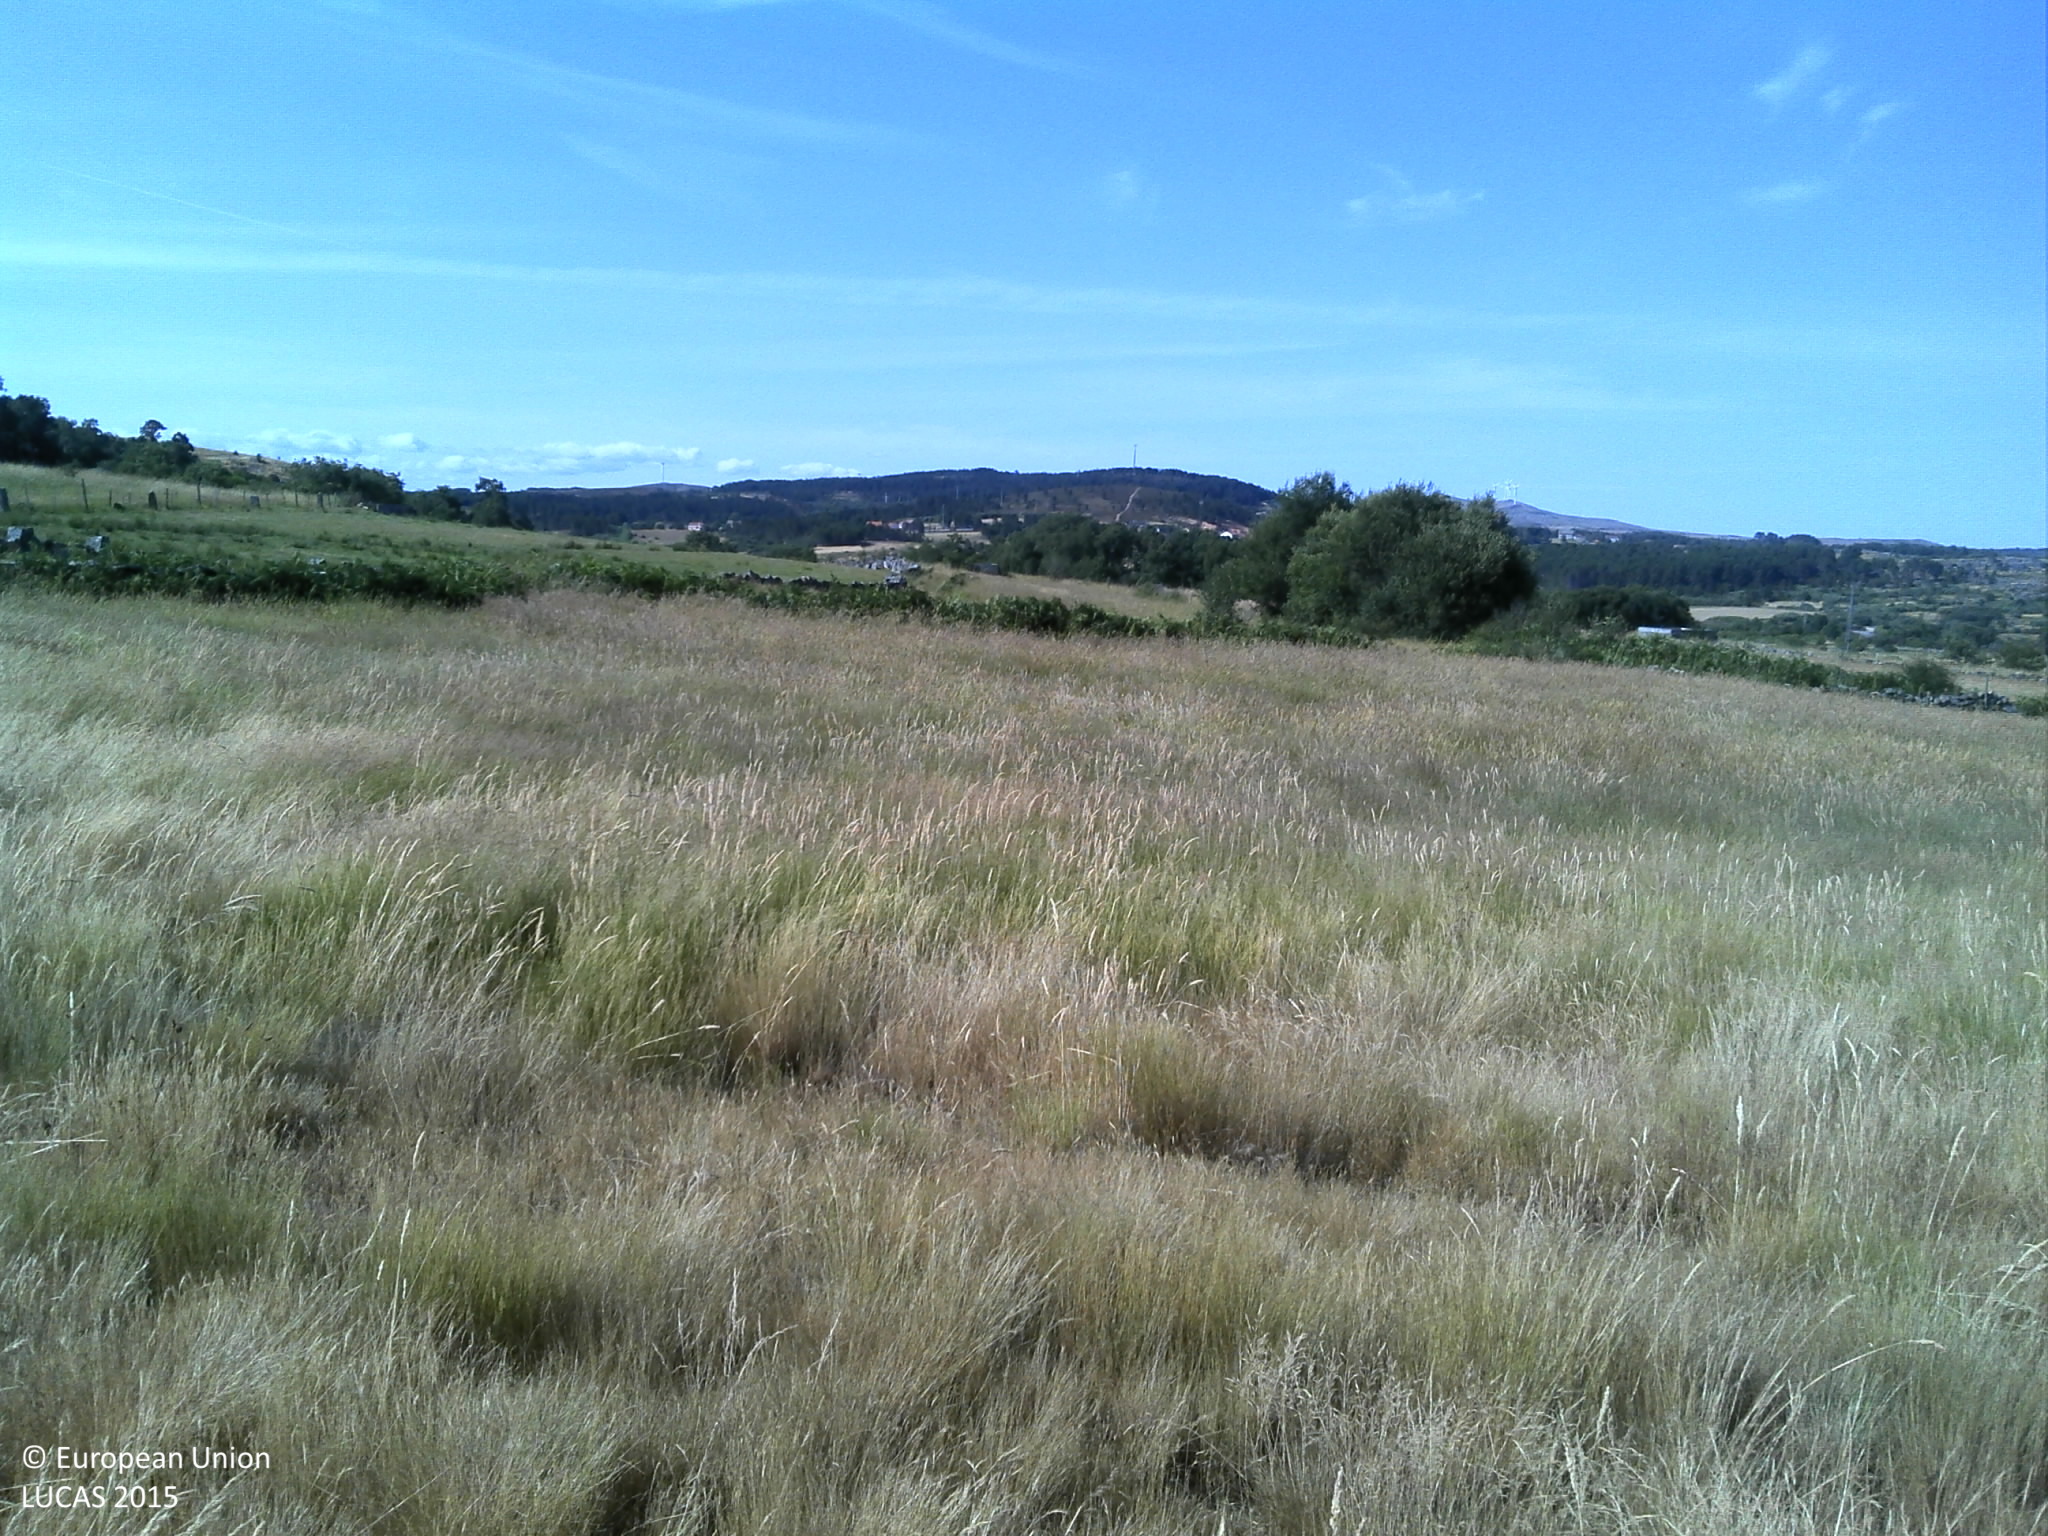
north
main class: Grassland
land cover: Grassland without tree/shrub cover
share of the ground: > 75 %
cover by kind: herbaceous plants 90 %, unconsolidated bare surface 10 %
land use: Agriculture (excluding fallow land and kitchen gardens)
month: July
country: PT
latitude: 41.4816
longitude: -7.7258
